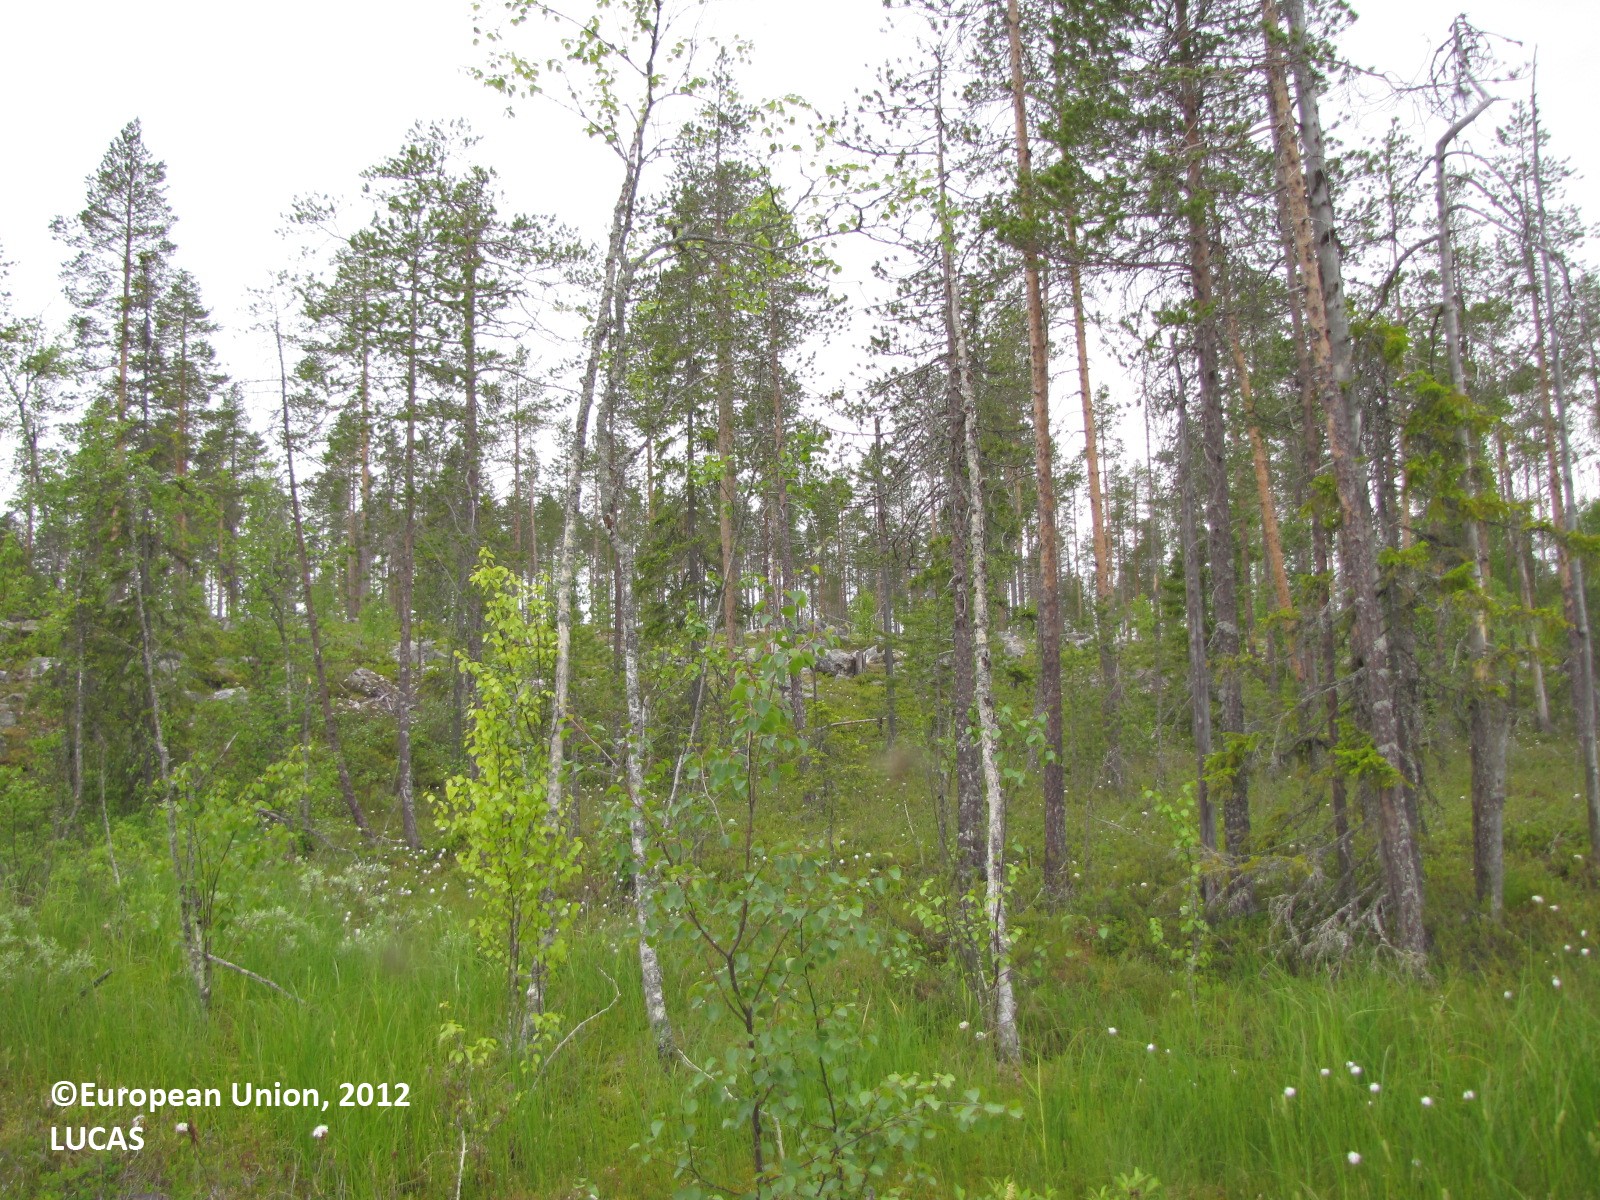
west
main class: Woodland
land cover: Pine dominated mixed woodland
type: boreal forest
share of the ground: 10 - 25 %
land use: Forestry
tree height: > 5 m
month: June
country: FI
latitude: 66.1477
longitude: 24.8823
